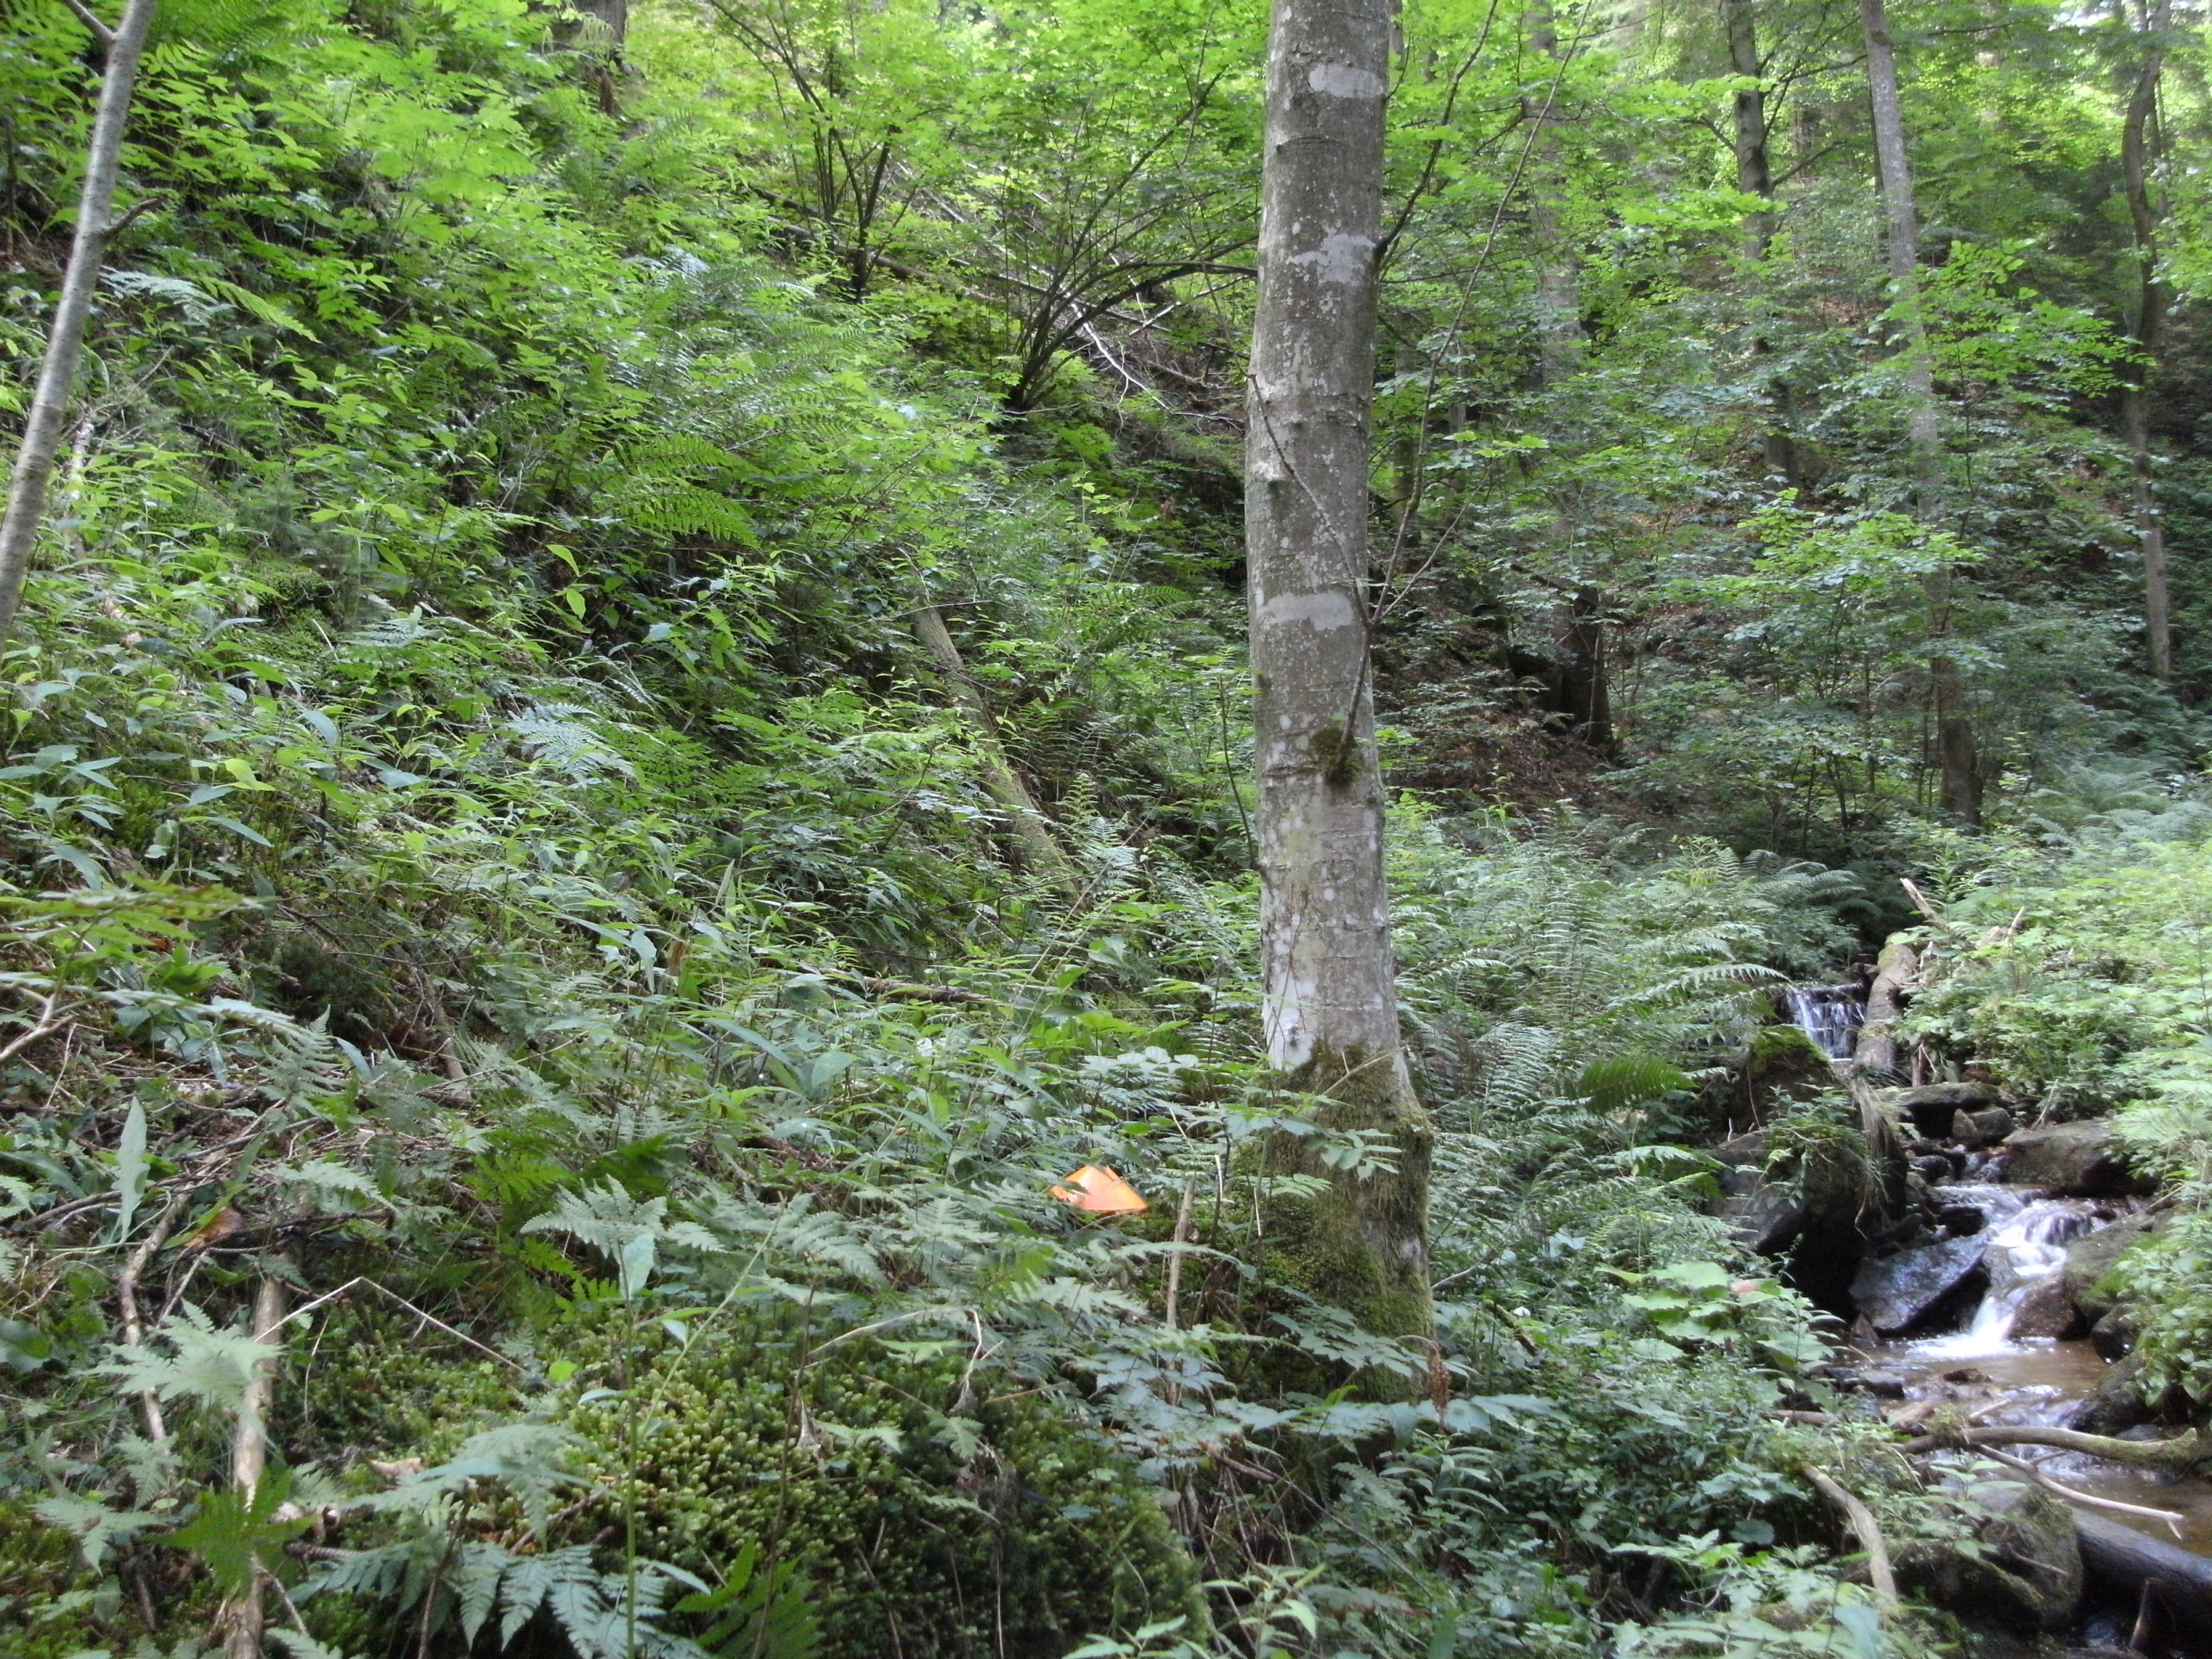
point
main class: Woodland
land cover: Spruce dominated mixed woodland
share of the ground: > 75 %
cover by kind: coniferous forest trees 45 %, broadleaved forest trees 30 %, shrubs 10 %, herbaceous plants 10 %, unconsolidated bare surface 5 %
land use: Forestry
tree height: > 5 m
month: July
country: AT
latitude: 46.8239
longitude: 14.7303
